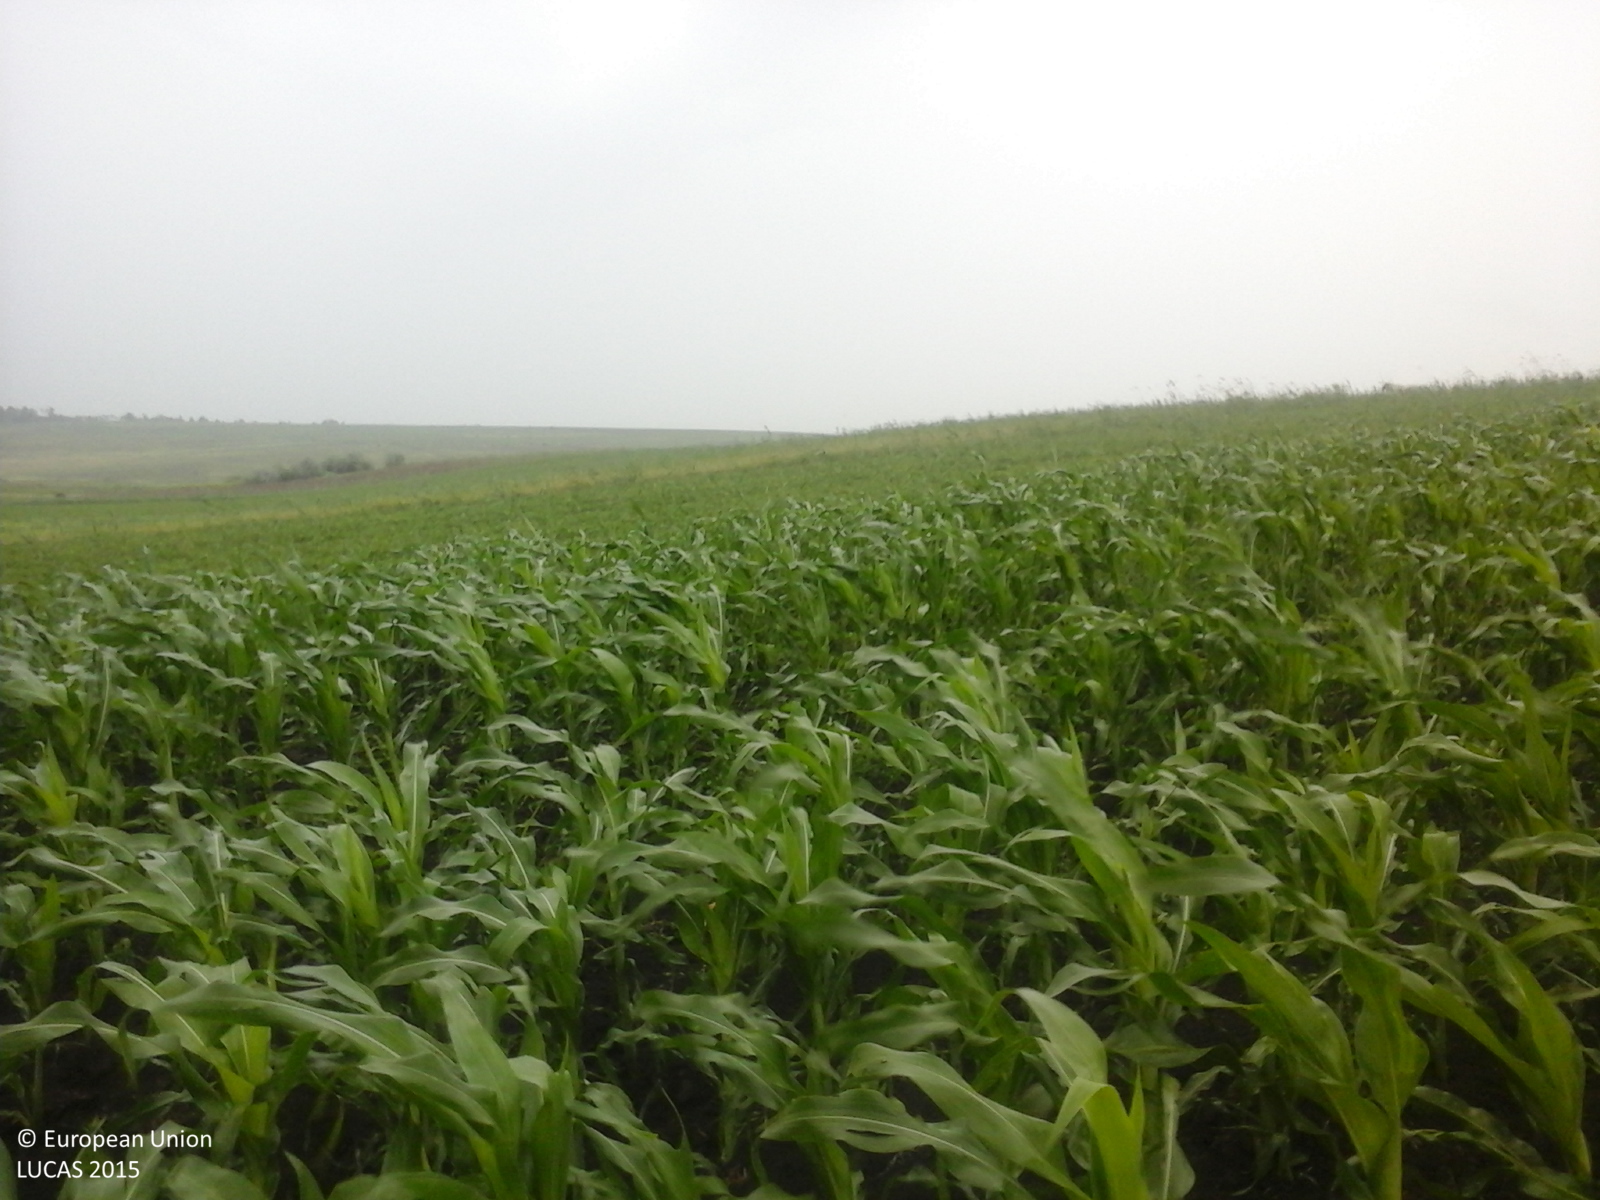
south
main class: Cropland
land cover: Maize
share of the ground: > 75 %
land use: Agriculture (excluding fallow land and kitchen gardens)
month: June
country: RO
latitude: 47.9018
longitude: 26.6432
